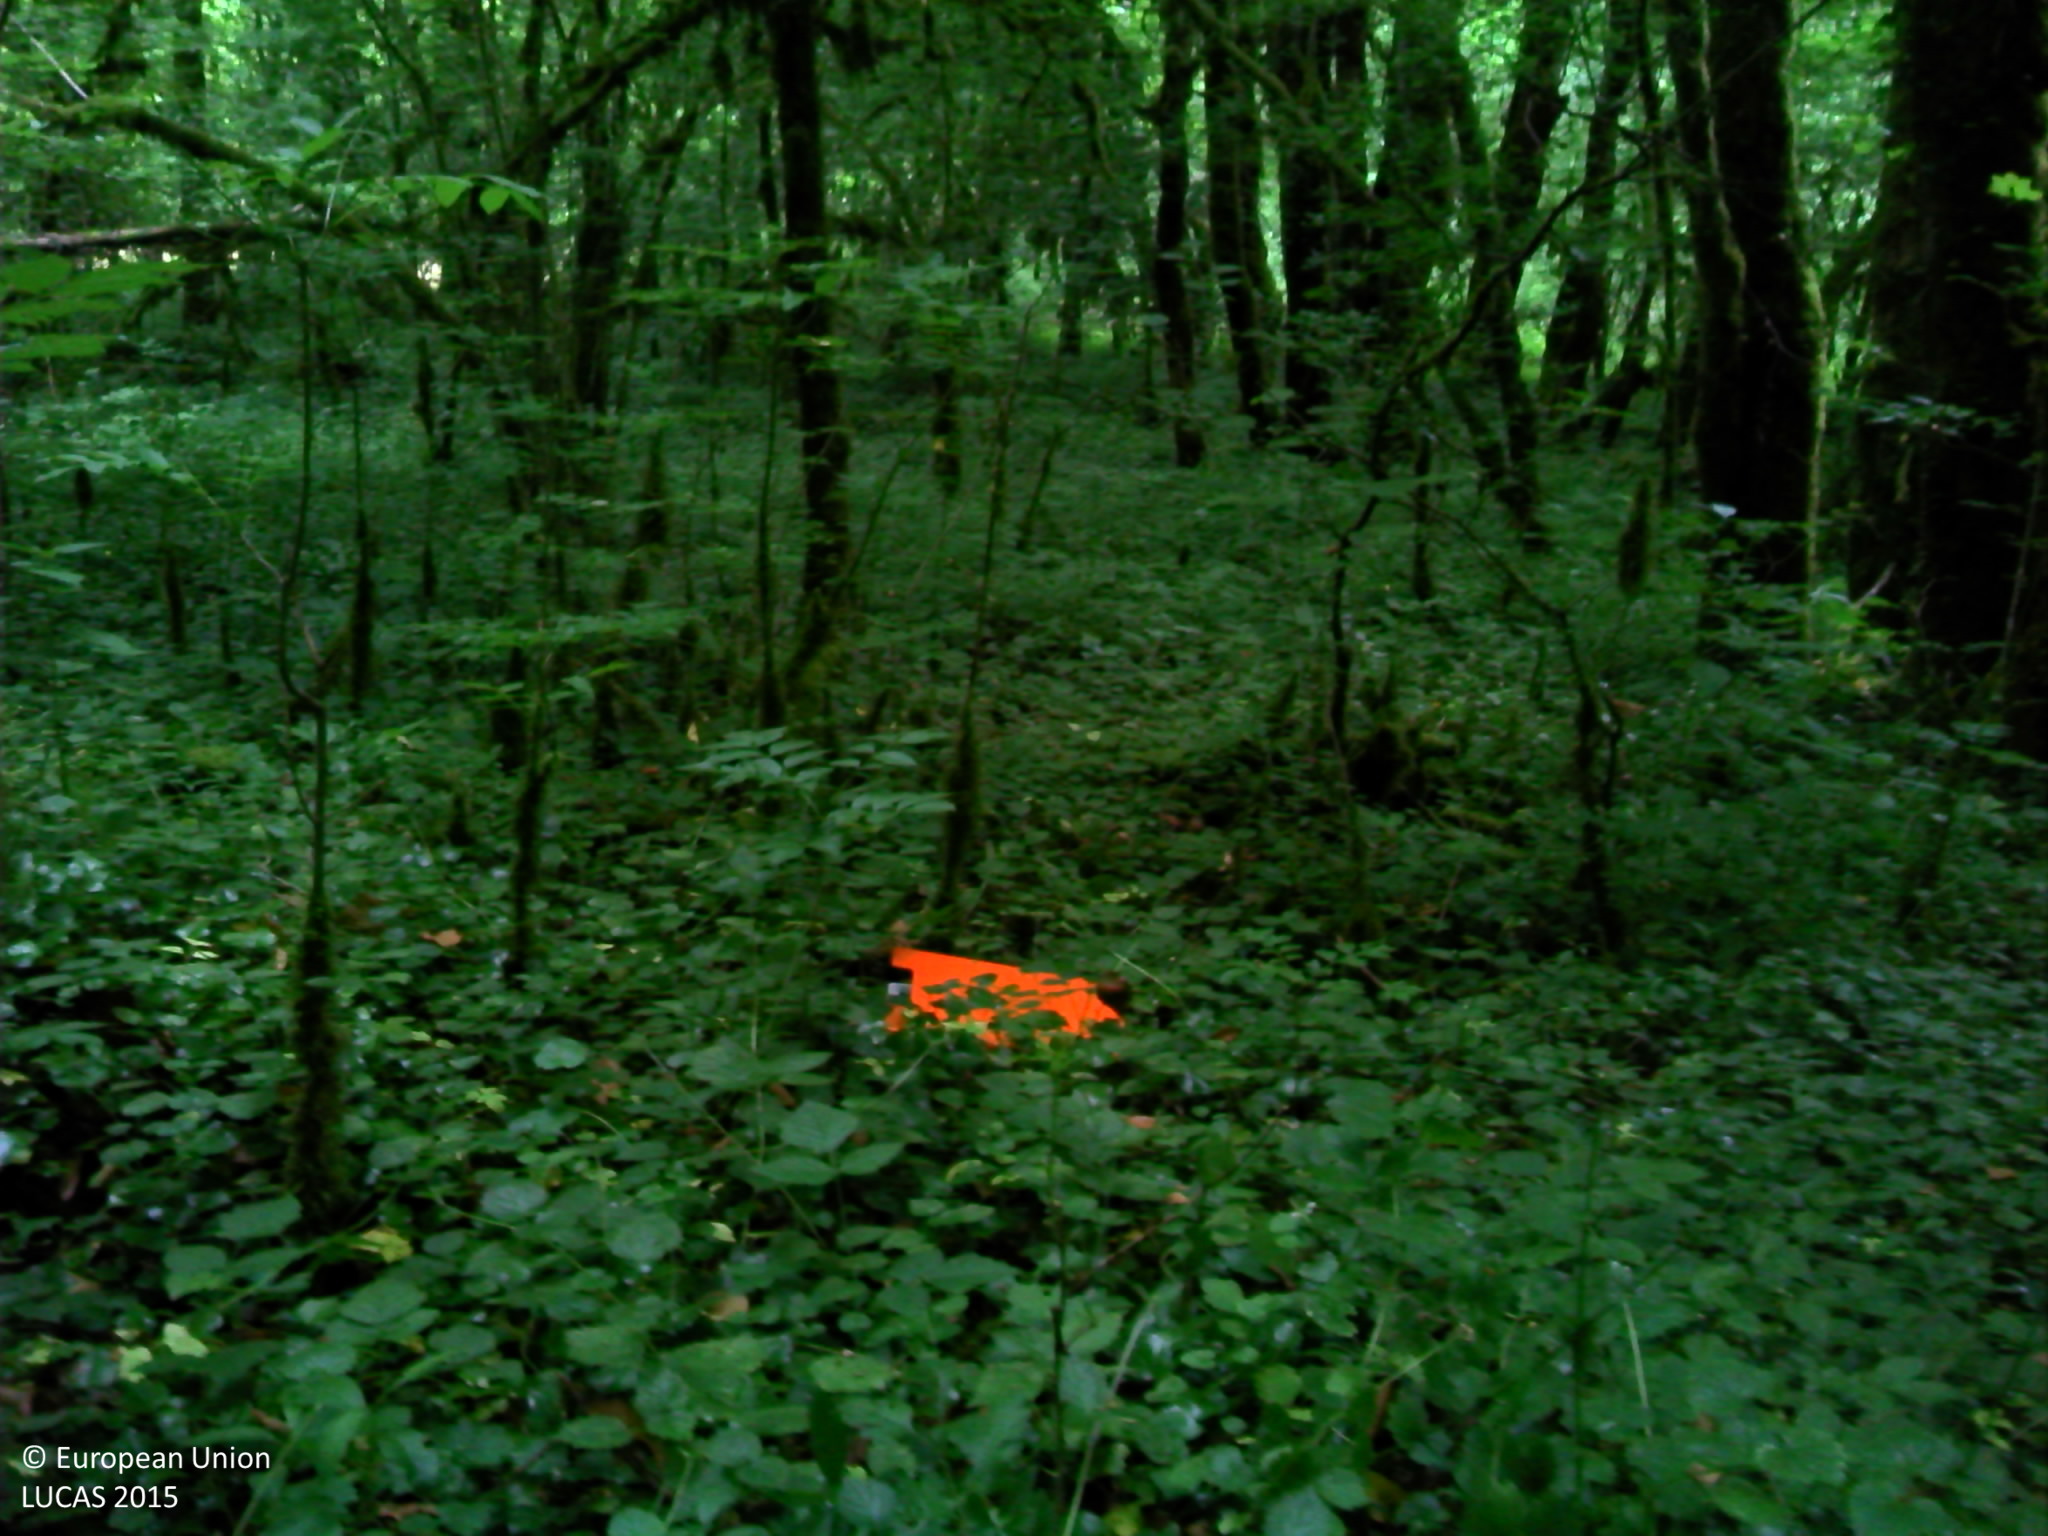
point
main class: Woodland
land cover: Broadleaved woodland
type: beech forest
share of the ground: > 75 %
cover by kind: broadleaved forest trees 90 %, herbaceous plants 10 %
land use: Forestry
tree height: > 5 m
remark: Harvested field
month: June
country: FR
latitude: 47.7285
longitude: 6.2813
